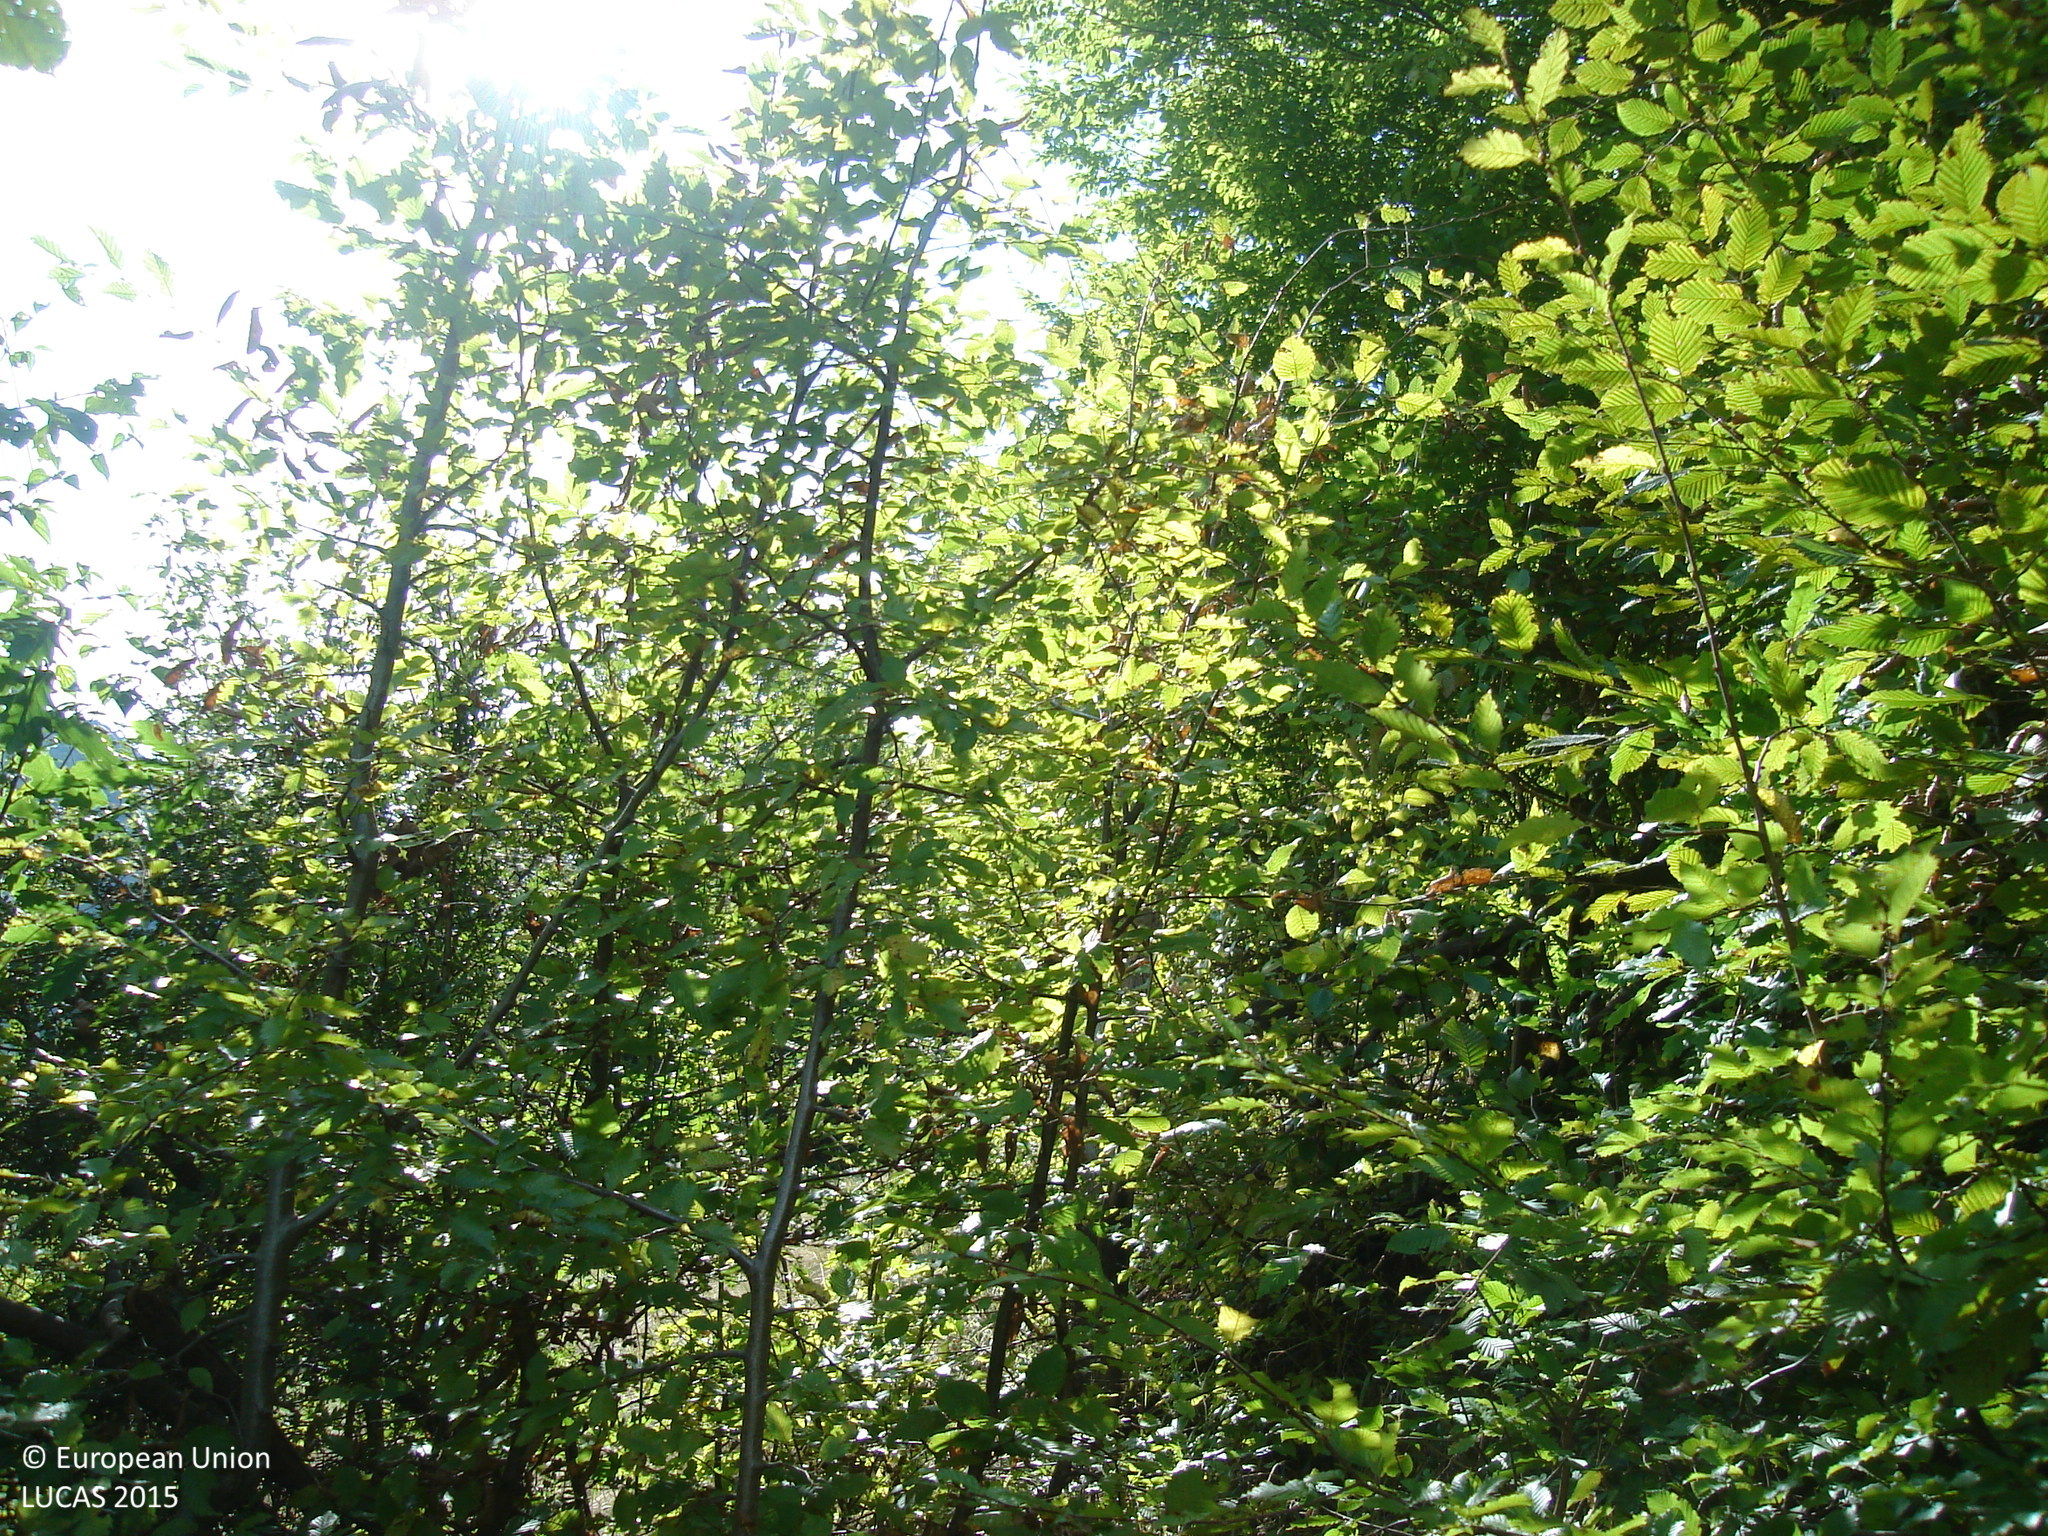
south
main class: Grassland
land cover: Grassland with sparse tree/shrub cover
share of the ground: > 75 %
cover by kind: herbaceous plants 85 %, shrubs 10 %, broadleaved forest trees 5 %
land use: Agriculture (excluding fallow land and kitchen gardens)
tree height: > 5 m
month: October
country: BG
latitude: 43.0281
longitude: 23.4780
